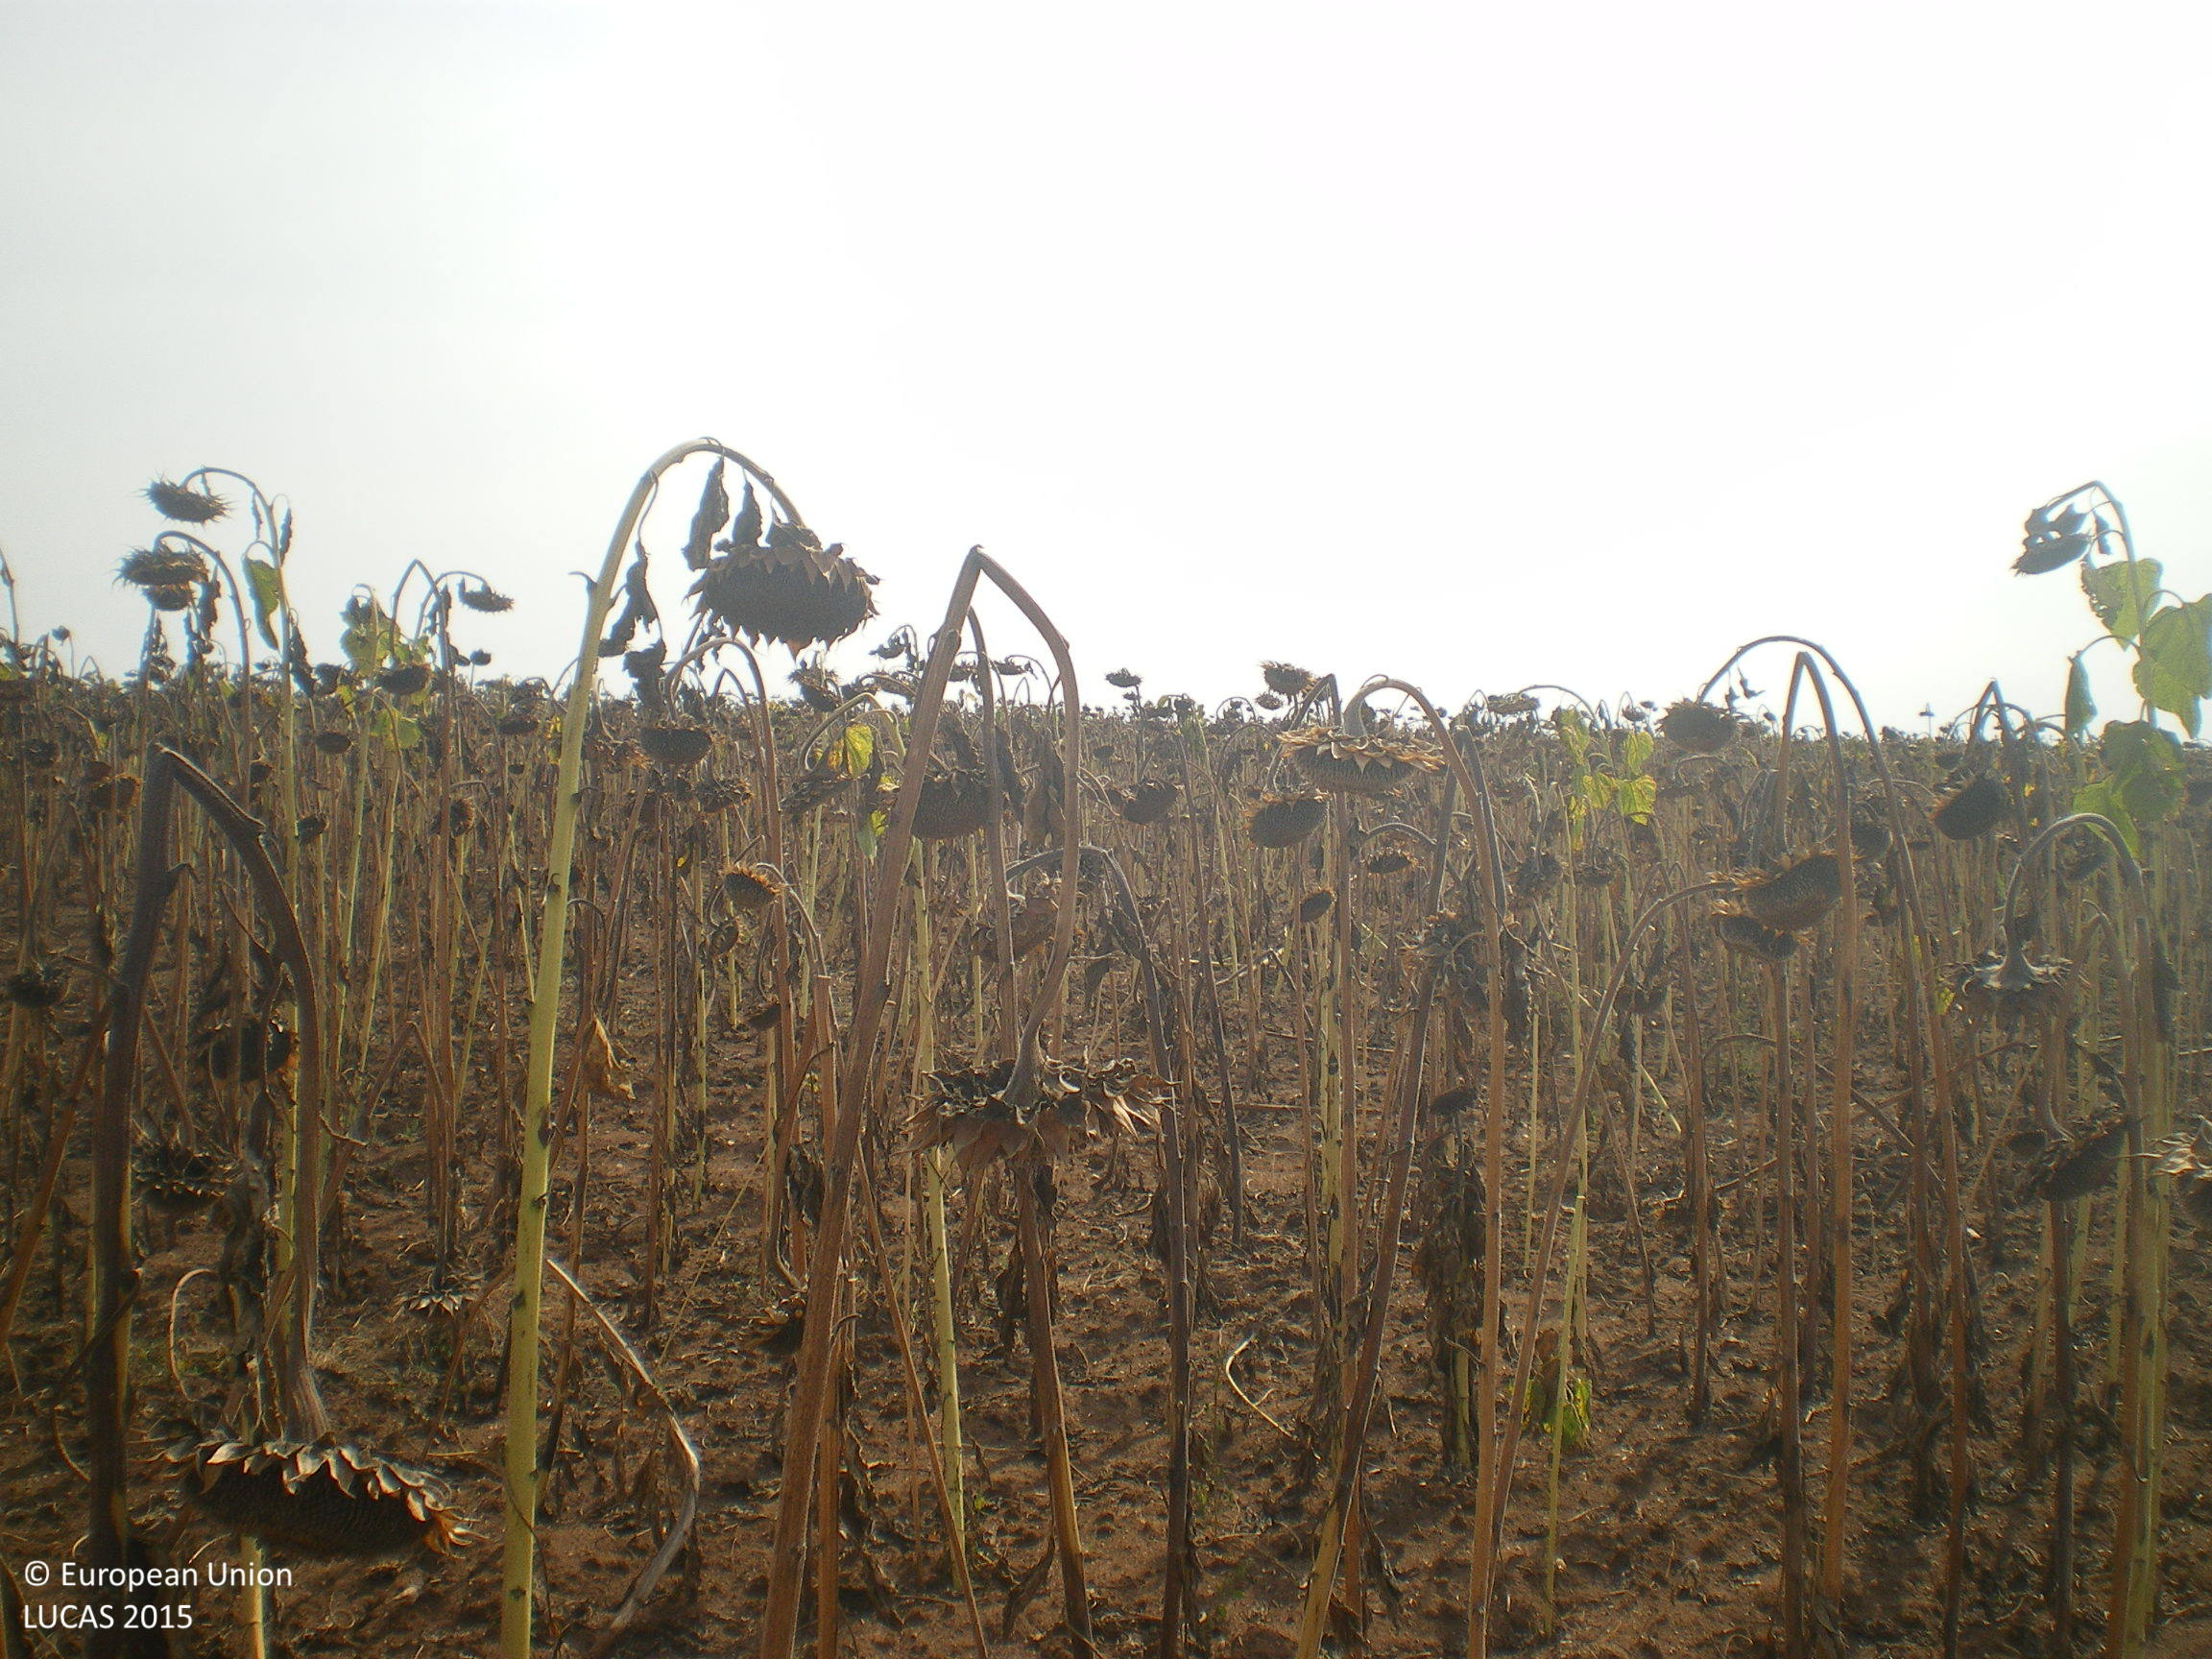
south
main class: Cropland
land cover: Sunflower
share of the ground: > 75 %
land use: Agriculture (excluding fallow land and kitchen gardens)
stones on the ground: < 10 %
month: September
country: BG
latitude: 42.1622
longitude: 26.1164
